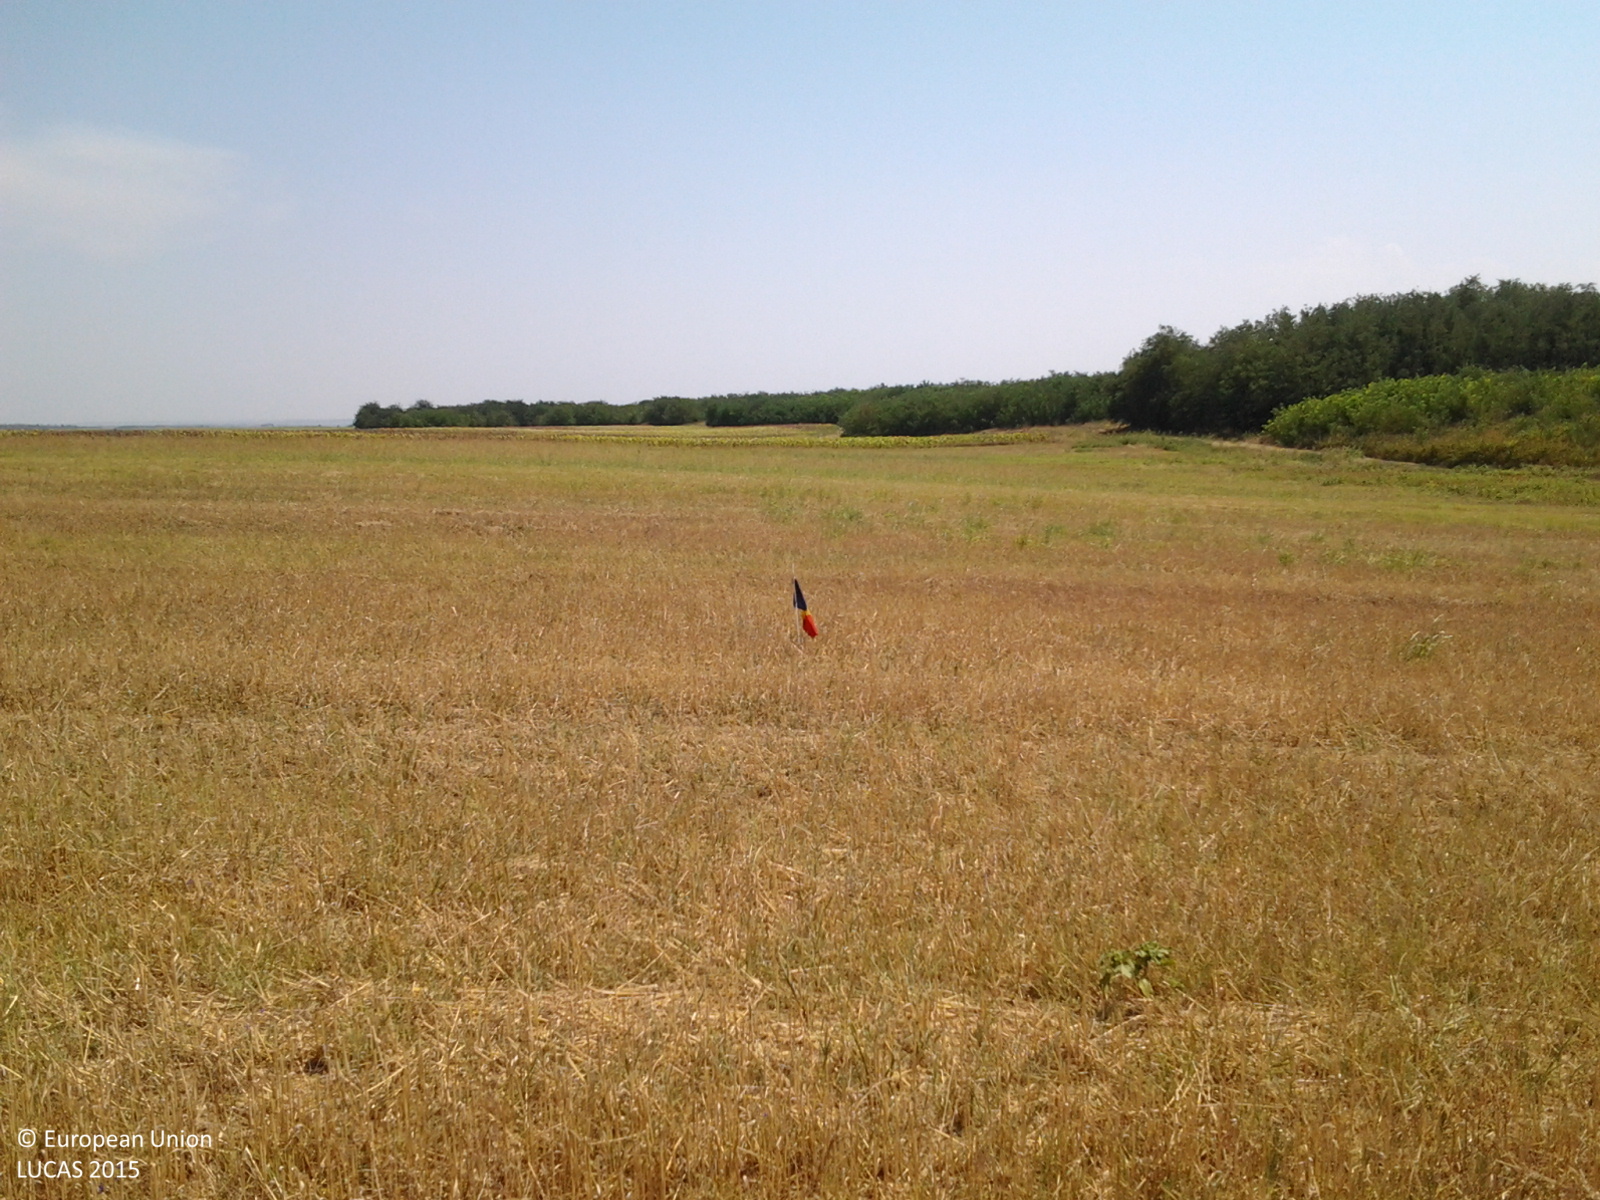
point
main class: Cropland
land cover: Common wheat
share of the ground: 50 - 75 %
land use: Agriculture (excluding fallow land and kitchen gardens)
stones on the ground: < 10 %
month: August
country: RO
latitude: 43.8678
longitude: 22.9179
